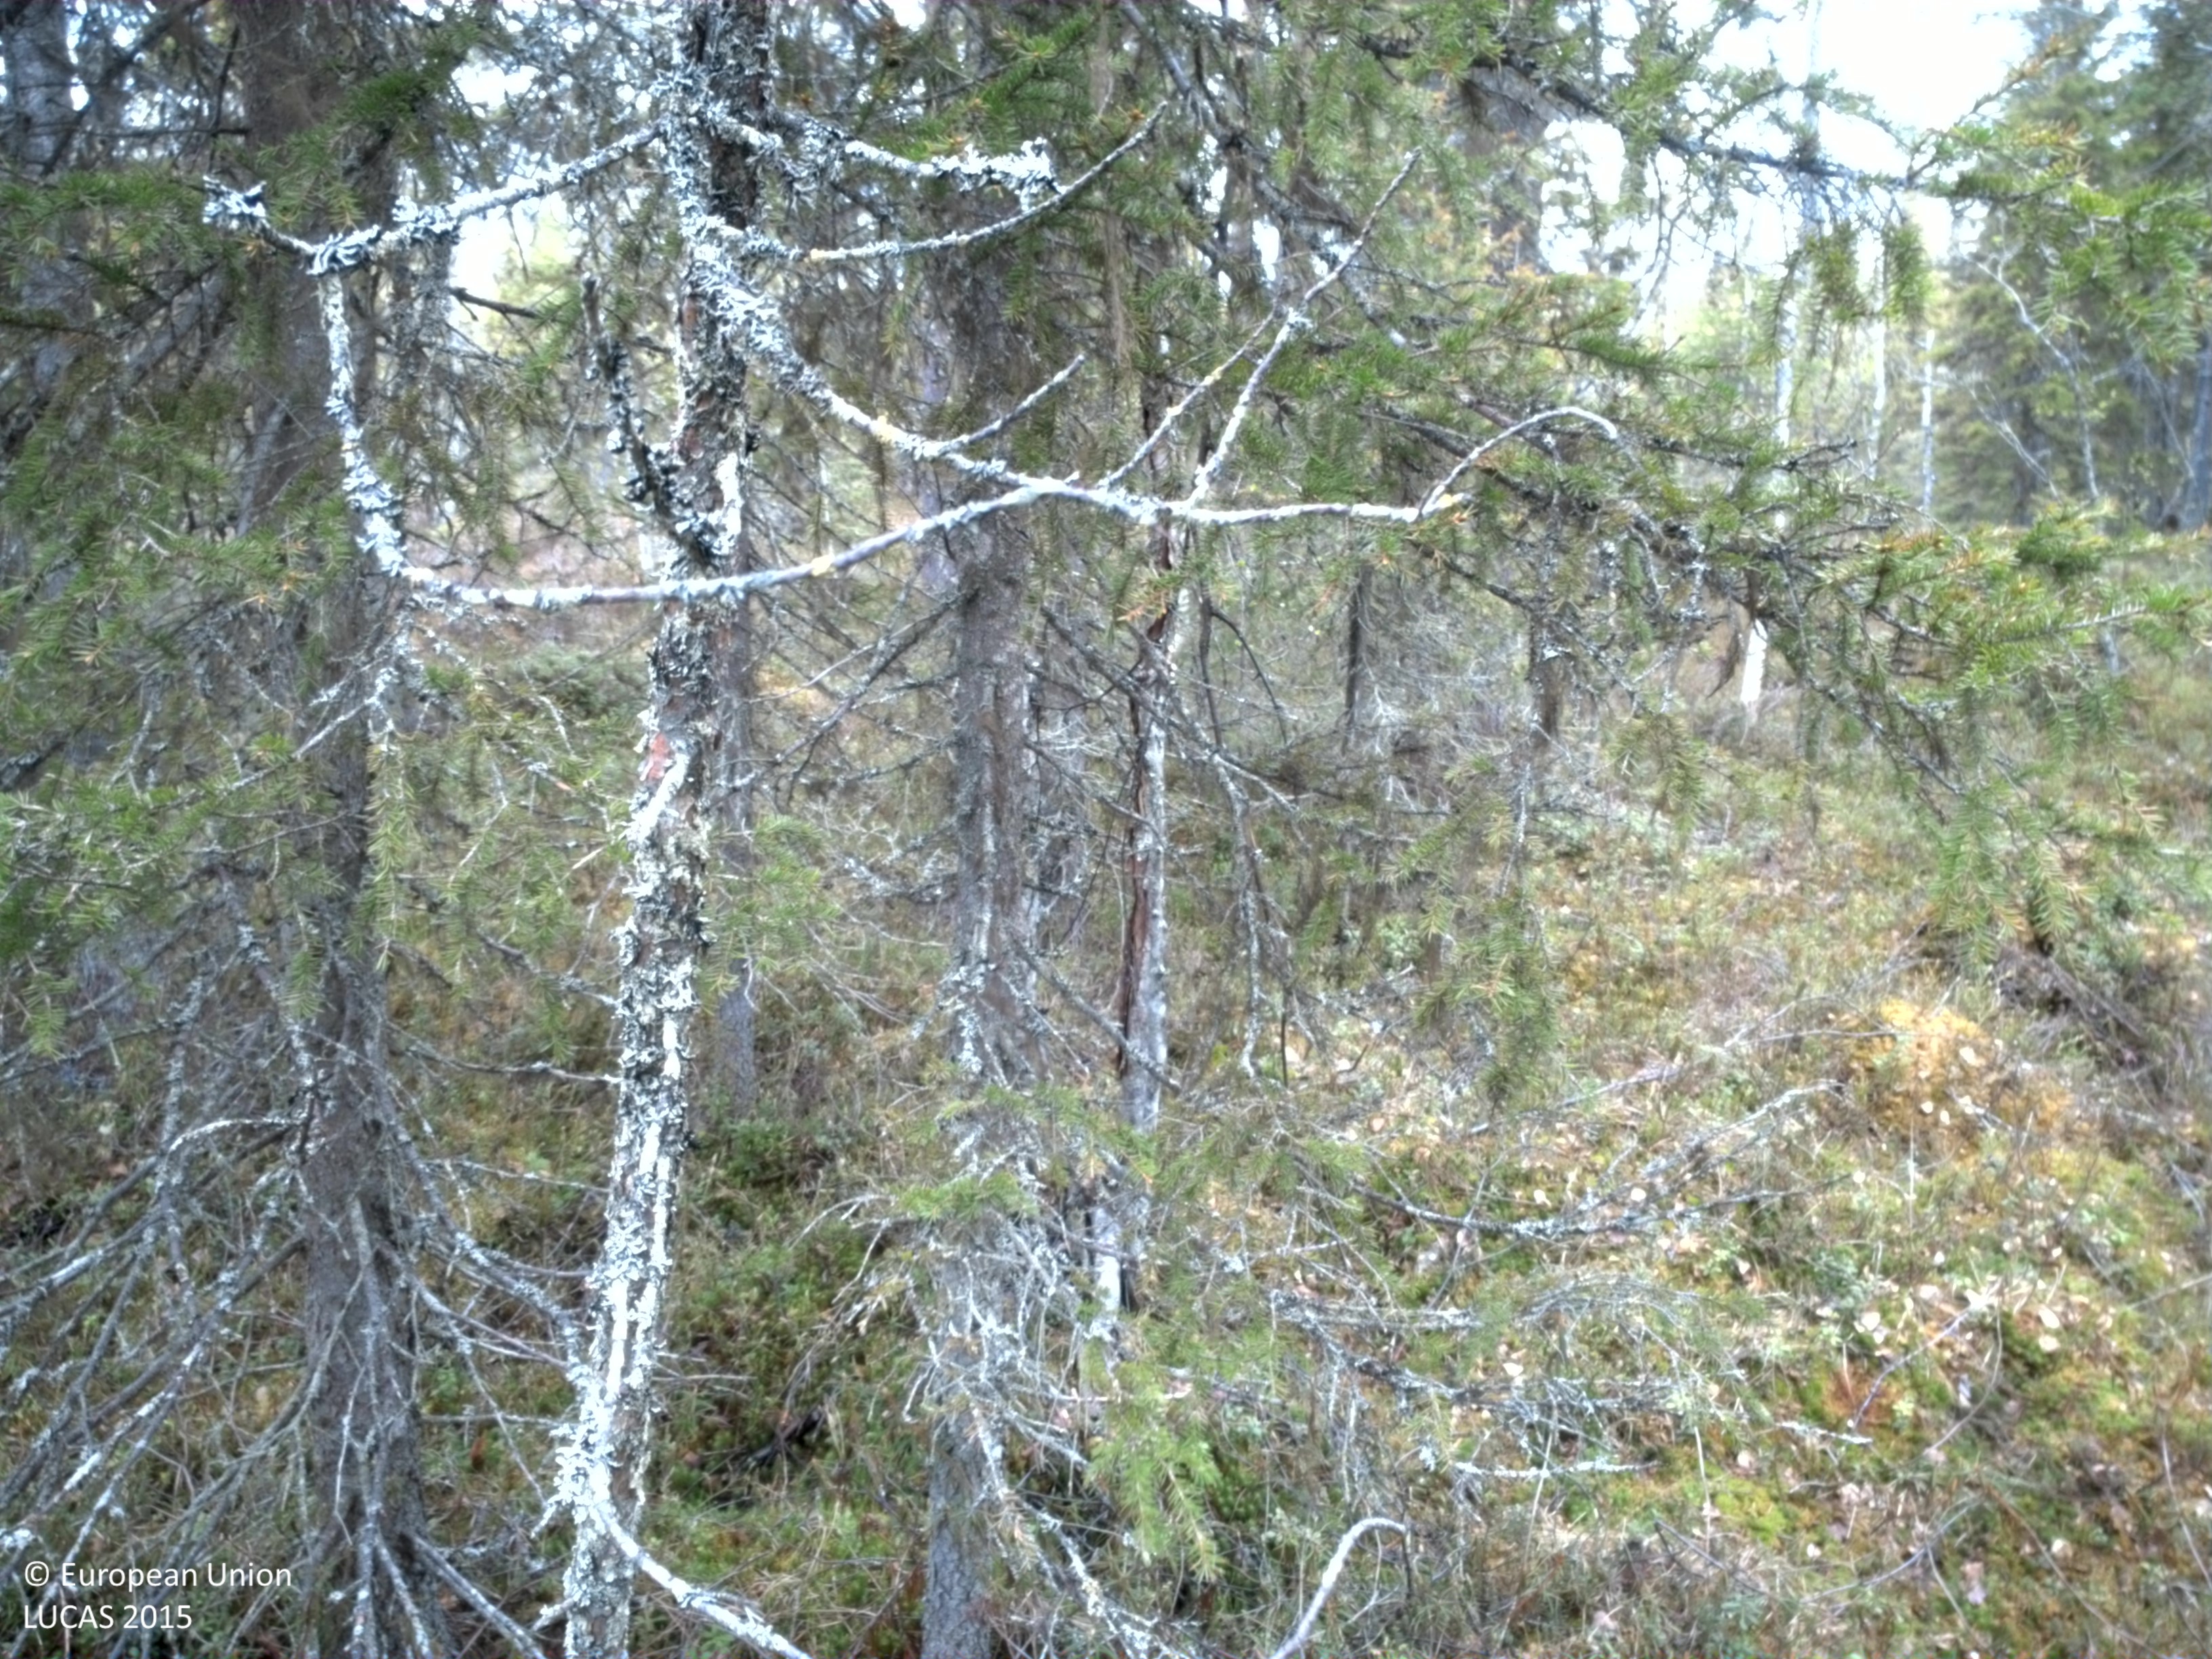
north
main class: Woodland
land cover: Spruce dominated mixed woodland
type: boreal forest
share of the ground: 50 - 75 %
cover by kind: coniferous forest trees 50 %, broadleaved forest trees 25 %, shrubs 25 %
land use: Forestry
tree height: > 5 m
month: June
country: SE
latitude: 66.4735
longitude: 23.4311
